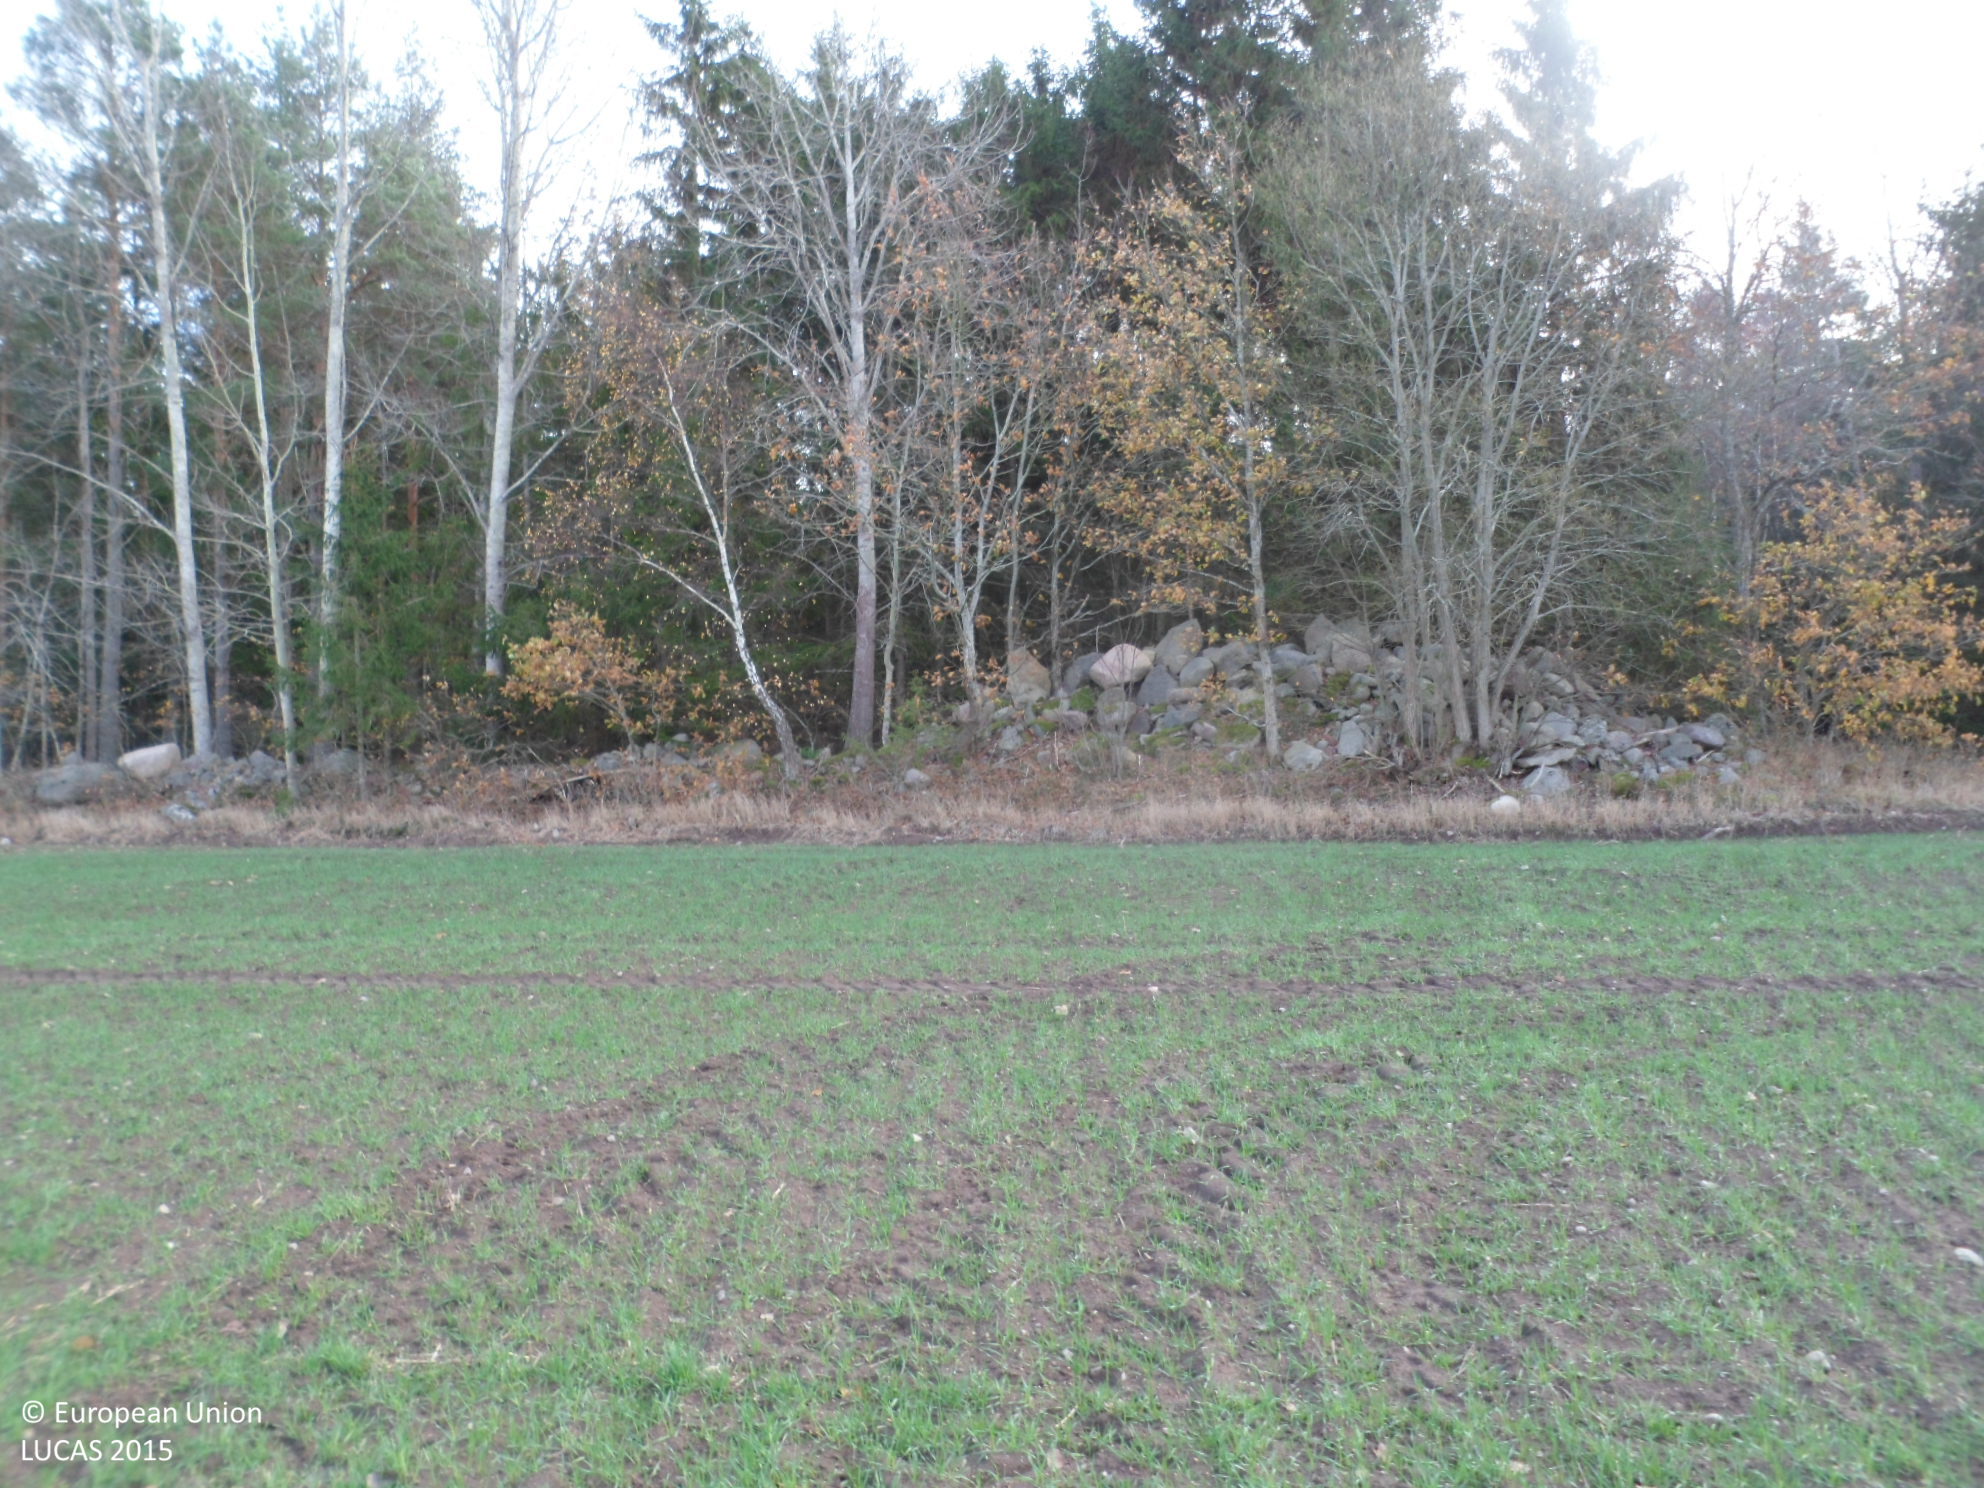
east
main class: Cropland
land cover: Common wheat
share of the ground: 25 - 50 %
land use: Agriculture (excluding fallow land and kitchen gardens)
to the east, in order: Common wheat; Groves; Dry stone walls; Spruce dominated mixed woodland; Spruce dominated coniferous woodland; Tracks; Spruce dominated coniferous woodland
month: November
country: SE
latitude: 56.6147
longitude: 16.2088
